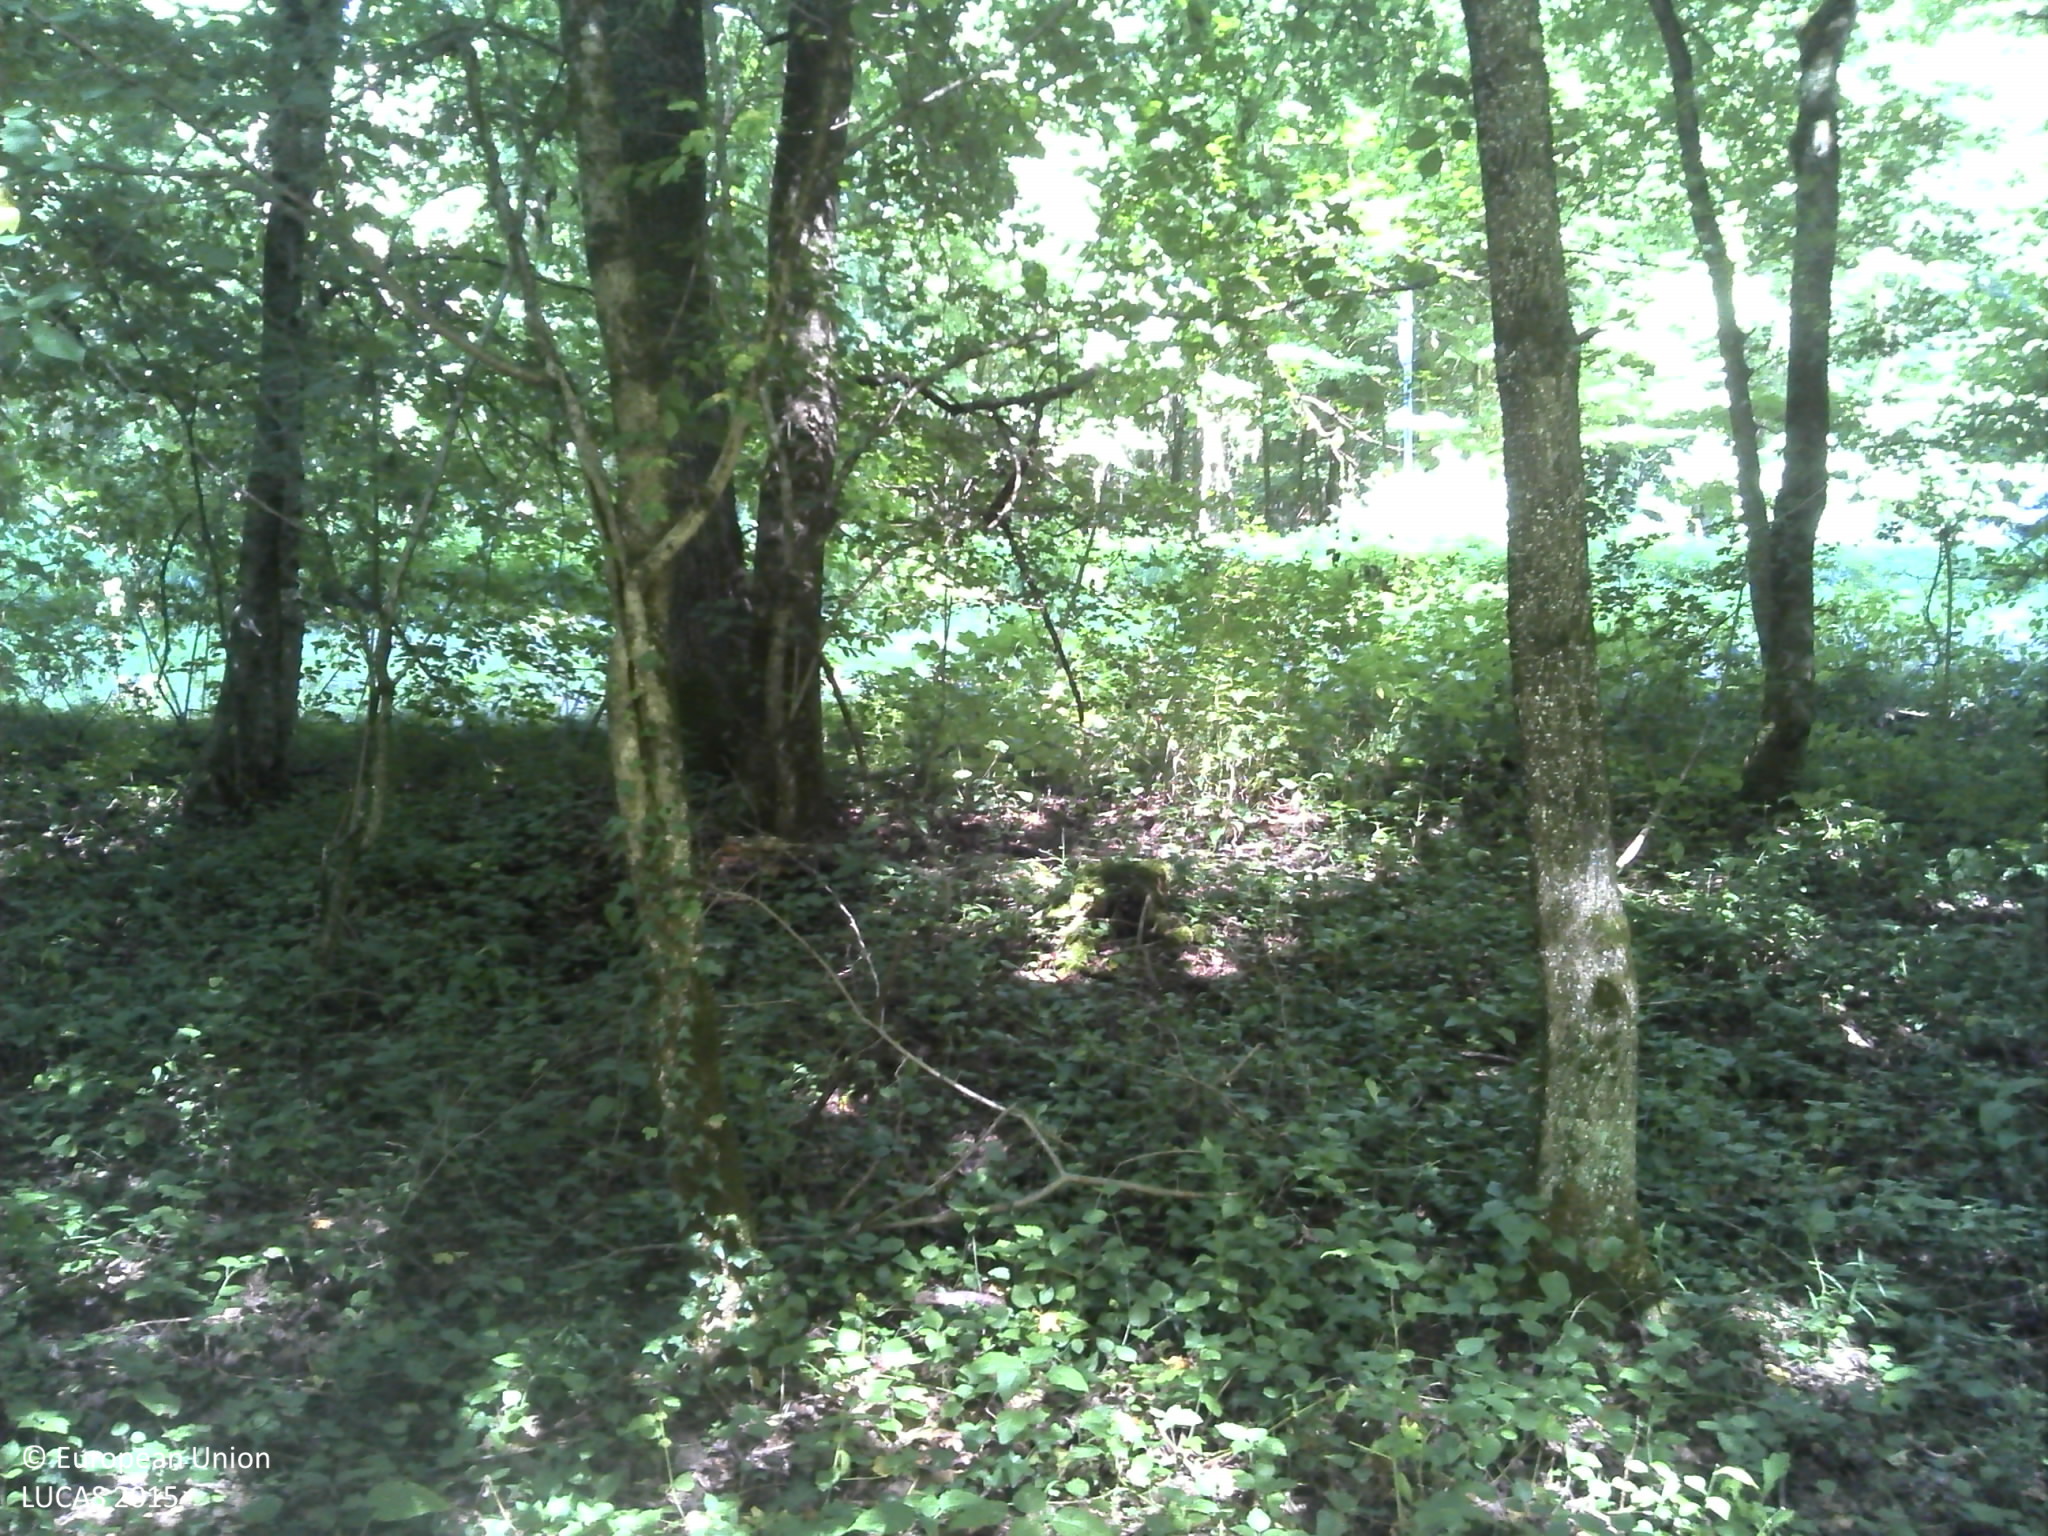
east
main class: Woodland
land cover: Broadleaved woodland
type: acidophilous oak and oak-birch forest
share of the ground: > 75 %
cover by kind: broadleaved forest trees 90 %, shrubs 5 %, herbaceous plants 5 %
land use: Forestry
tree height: > 5 m
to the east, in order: Broadleaved woodland; Grass margins; Paved roads, cycling and walking lanes; Ditches and canals; Grass margins; Broadleaved woodland; Spontaneously vegetated surfaces; Electric lines; Shrubland without tree cover; Broadleaved woodland
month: July
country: HR
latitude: 45.7535
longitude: 16.8262
